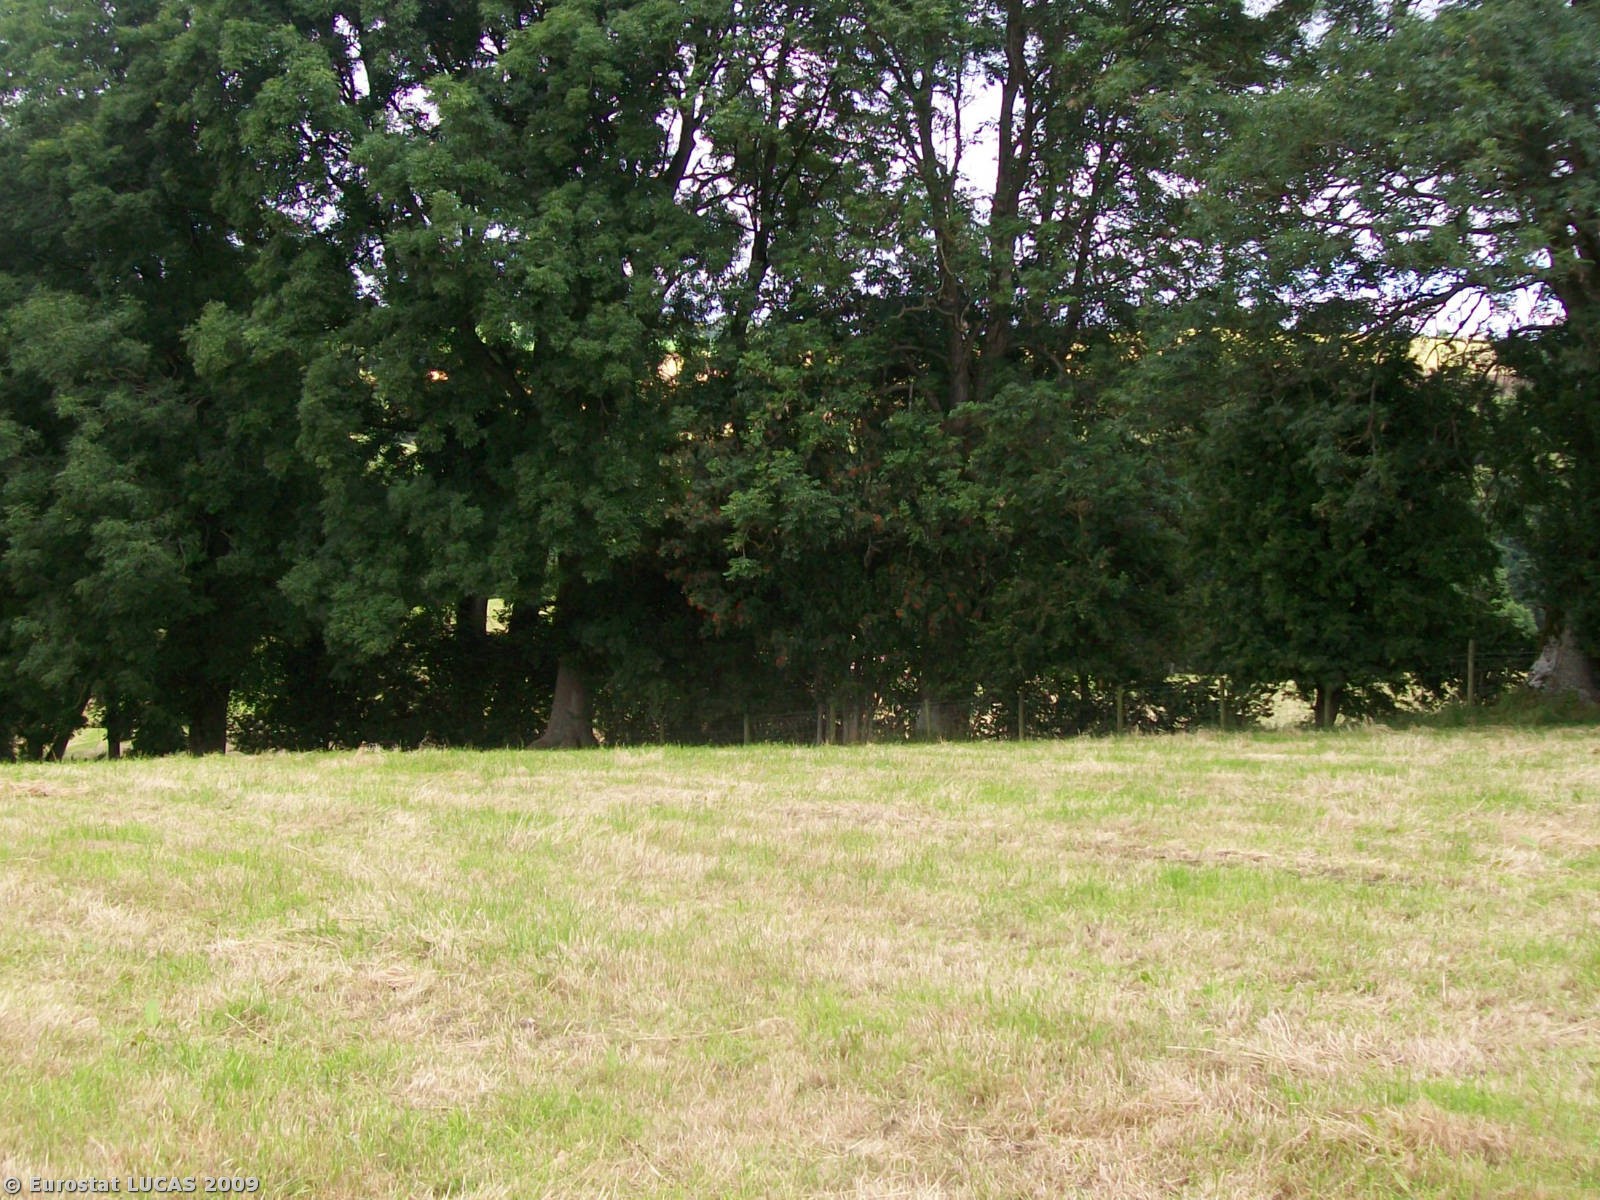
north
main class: Grassland
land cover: Grassland without tree/shrub cover
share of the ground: > 75 %
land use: Agriculture (excluding fallow land and kitchen gardens)
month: August
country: GB
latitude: 52.6030
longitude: -3.3556
